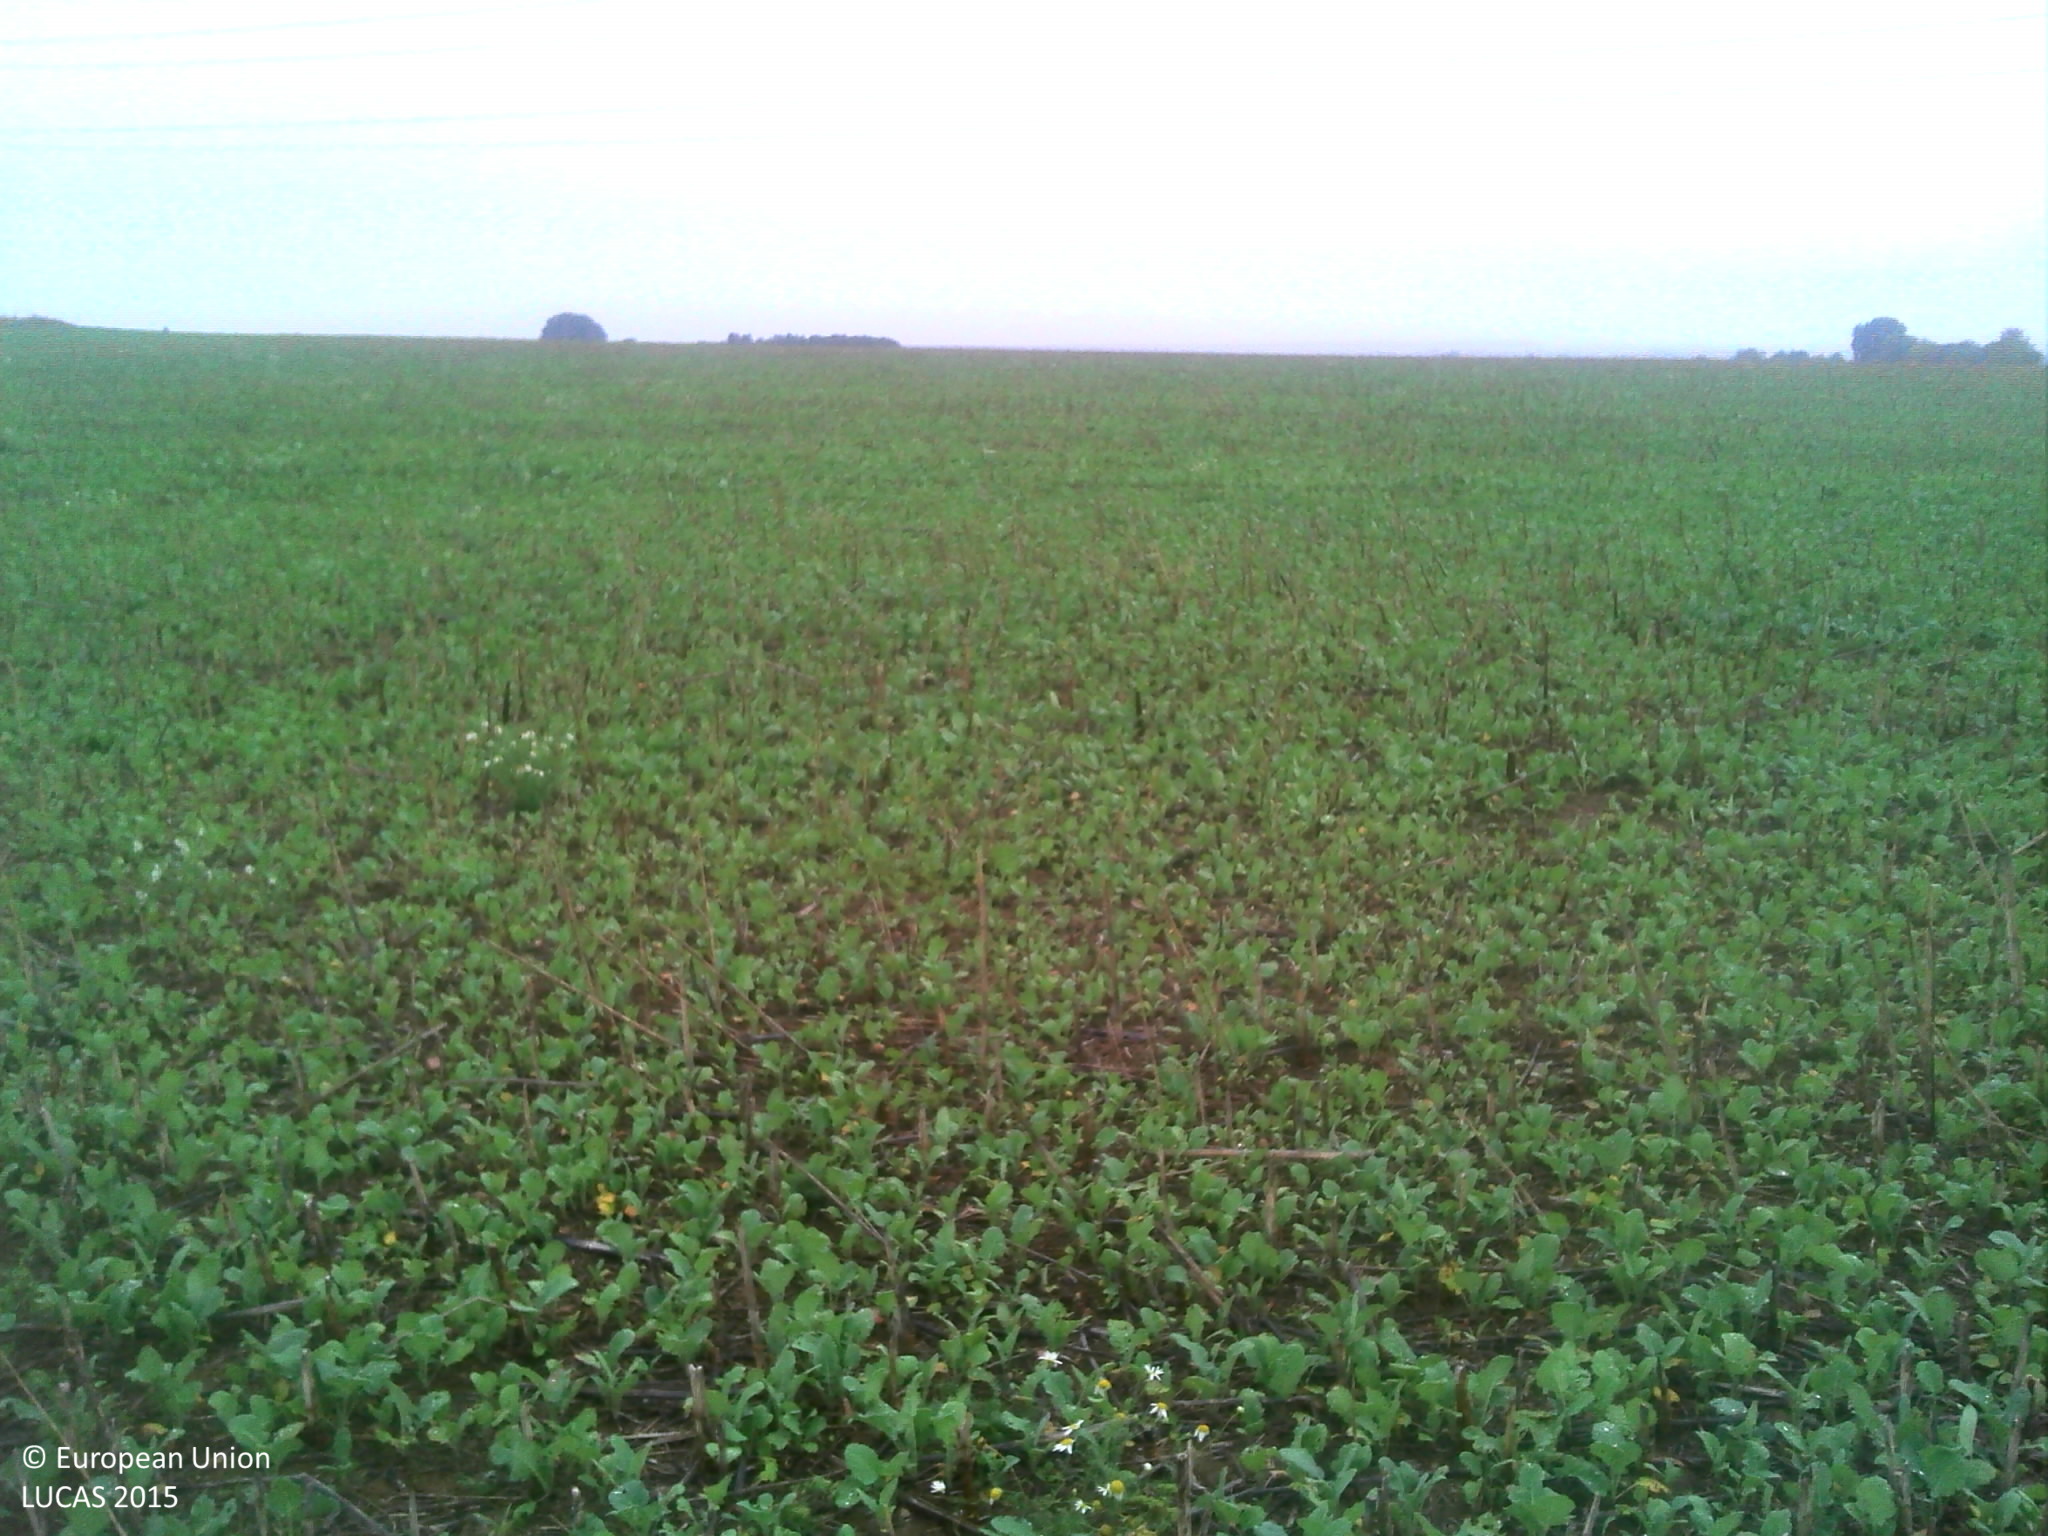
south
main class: Cropland
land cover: Rape and turnip rape
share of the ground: 10 - 25 %
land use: Agriculture (excluding fallow land and kitchen gardens)
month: September
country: FR
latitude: 49.2628
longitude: 5.8630
